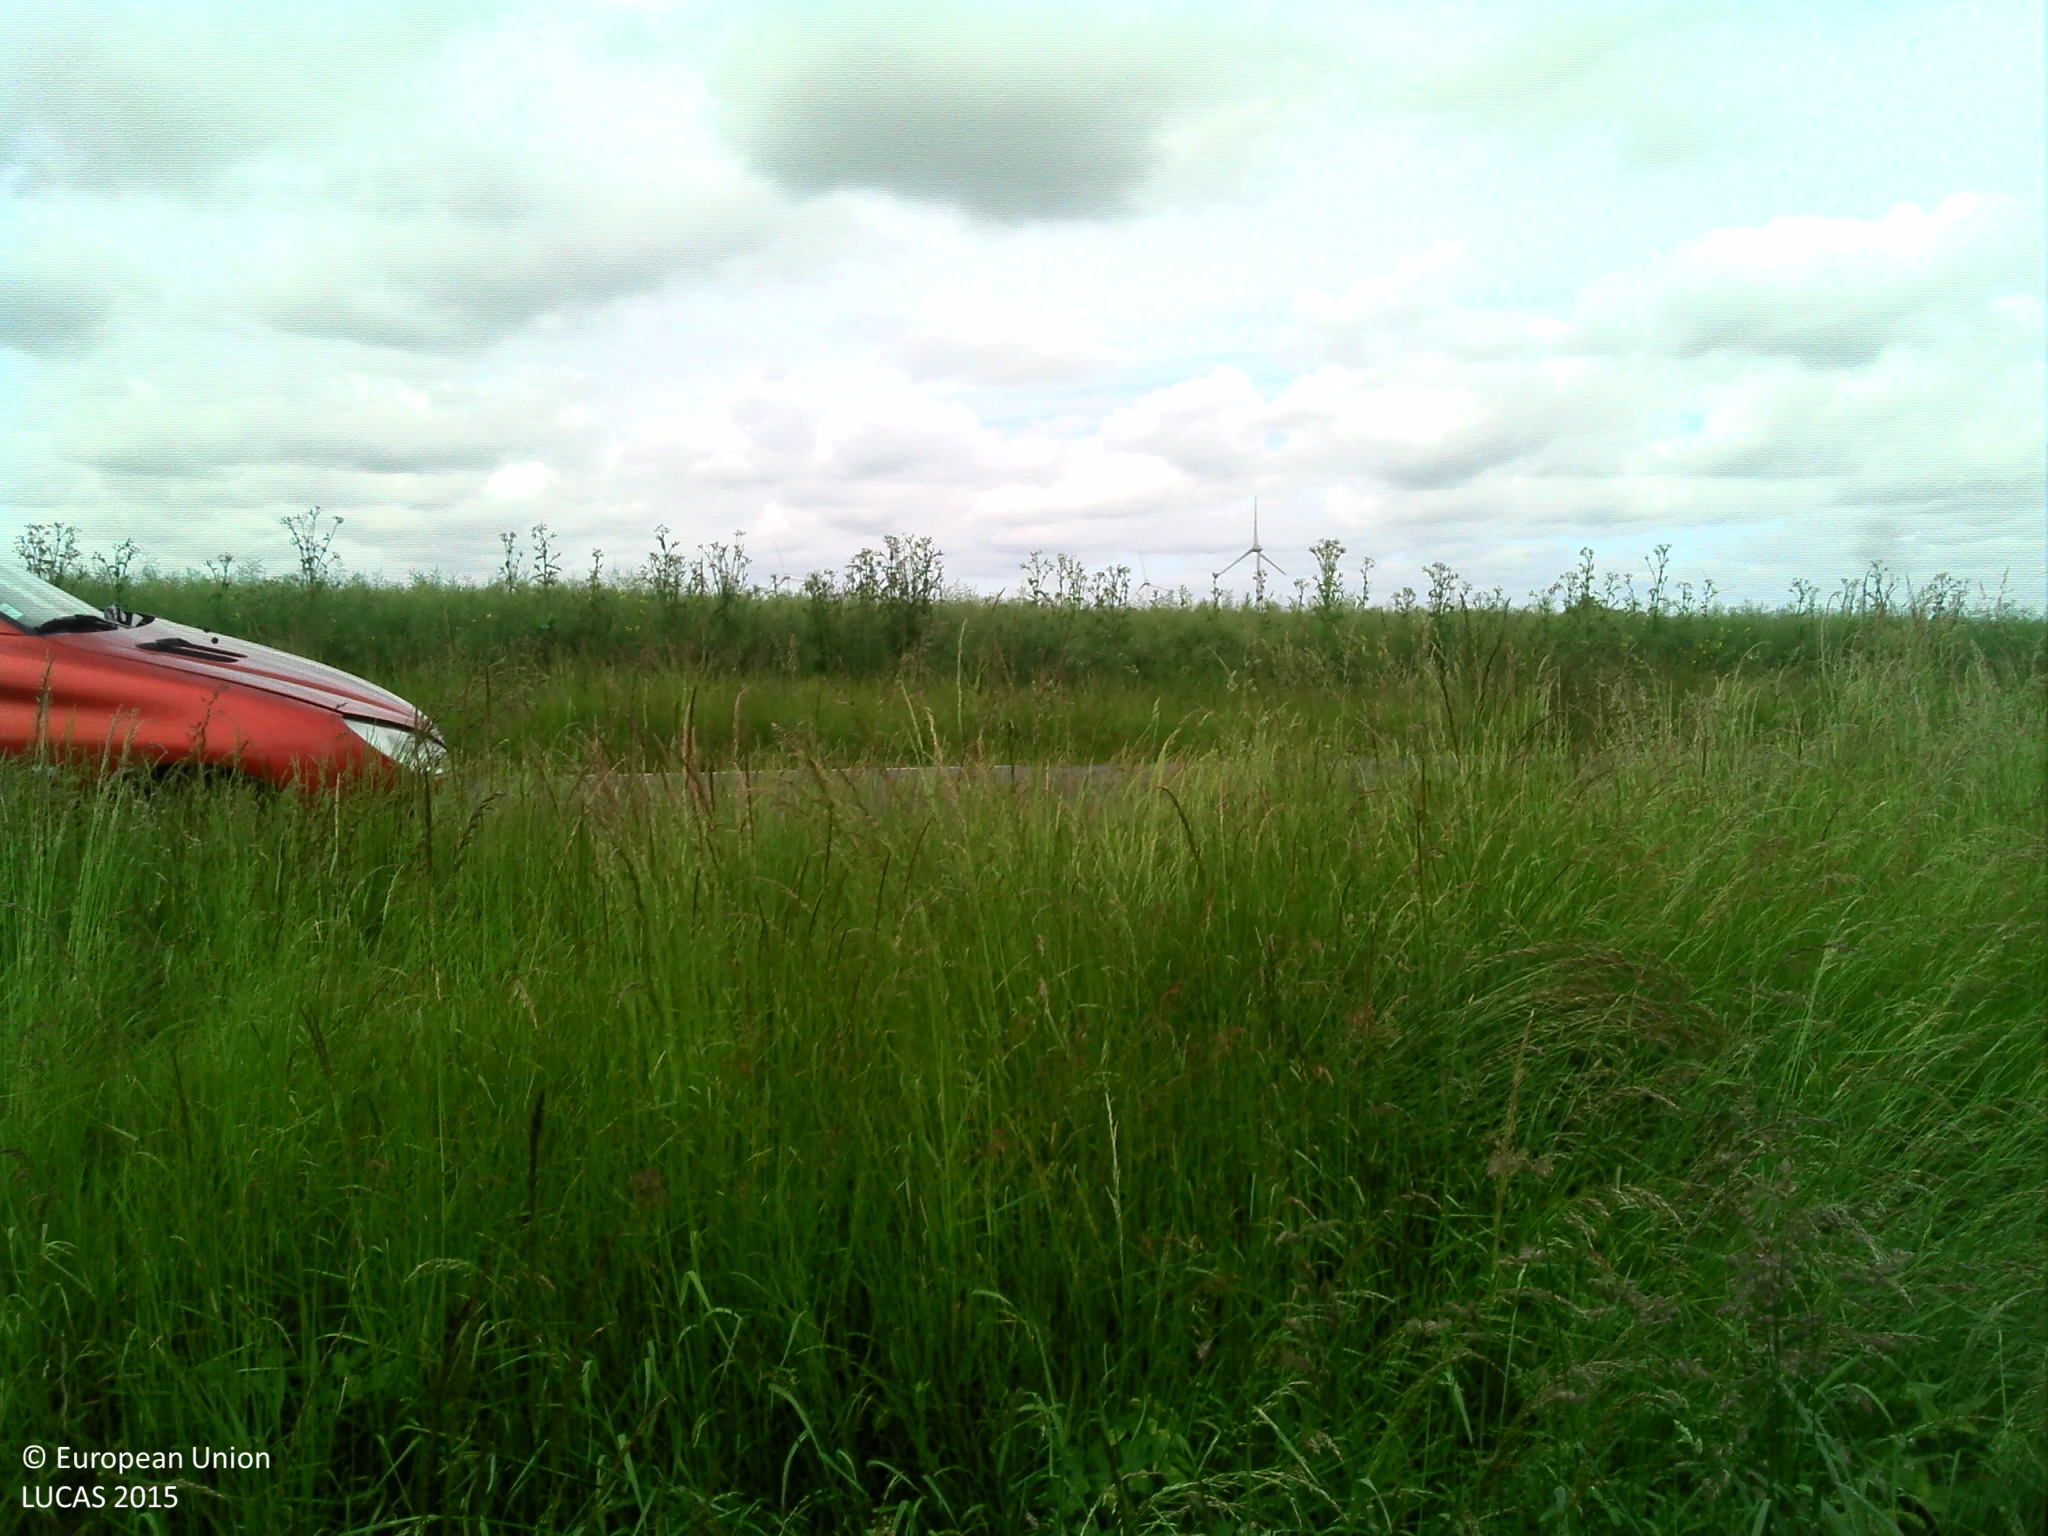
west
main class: Cropland
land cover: Rape and turnip rape
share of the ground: > 75 %
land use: Agriculture (excluding fallow land and kitchen gardens)
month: June
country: FR
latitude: 48.3652
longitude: 1.9824
